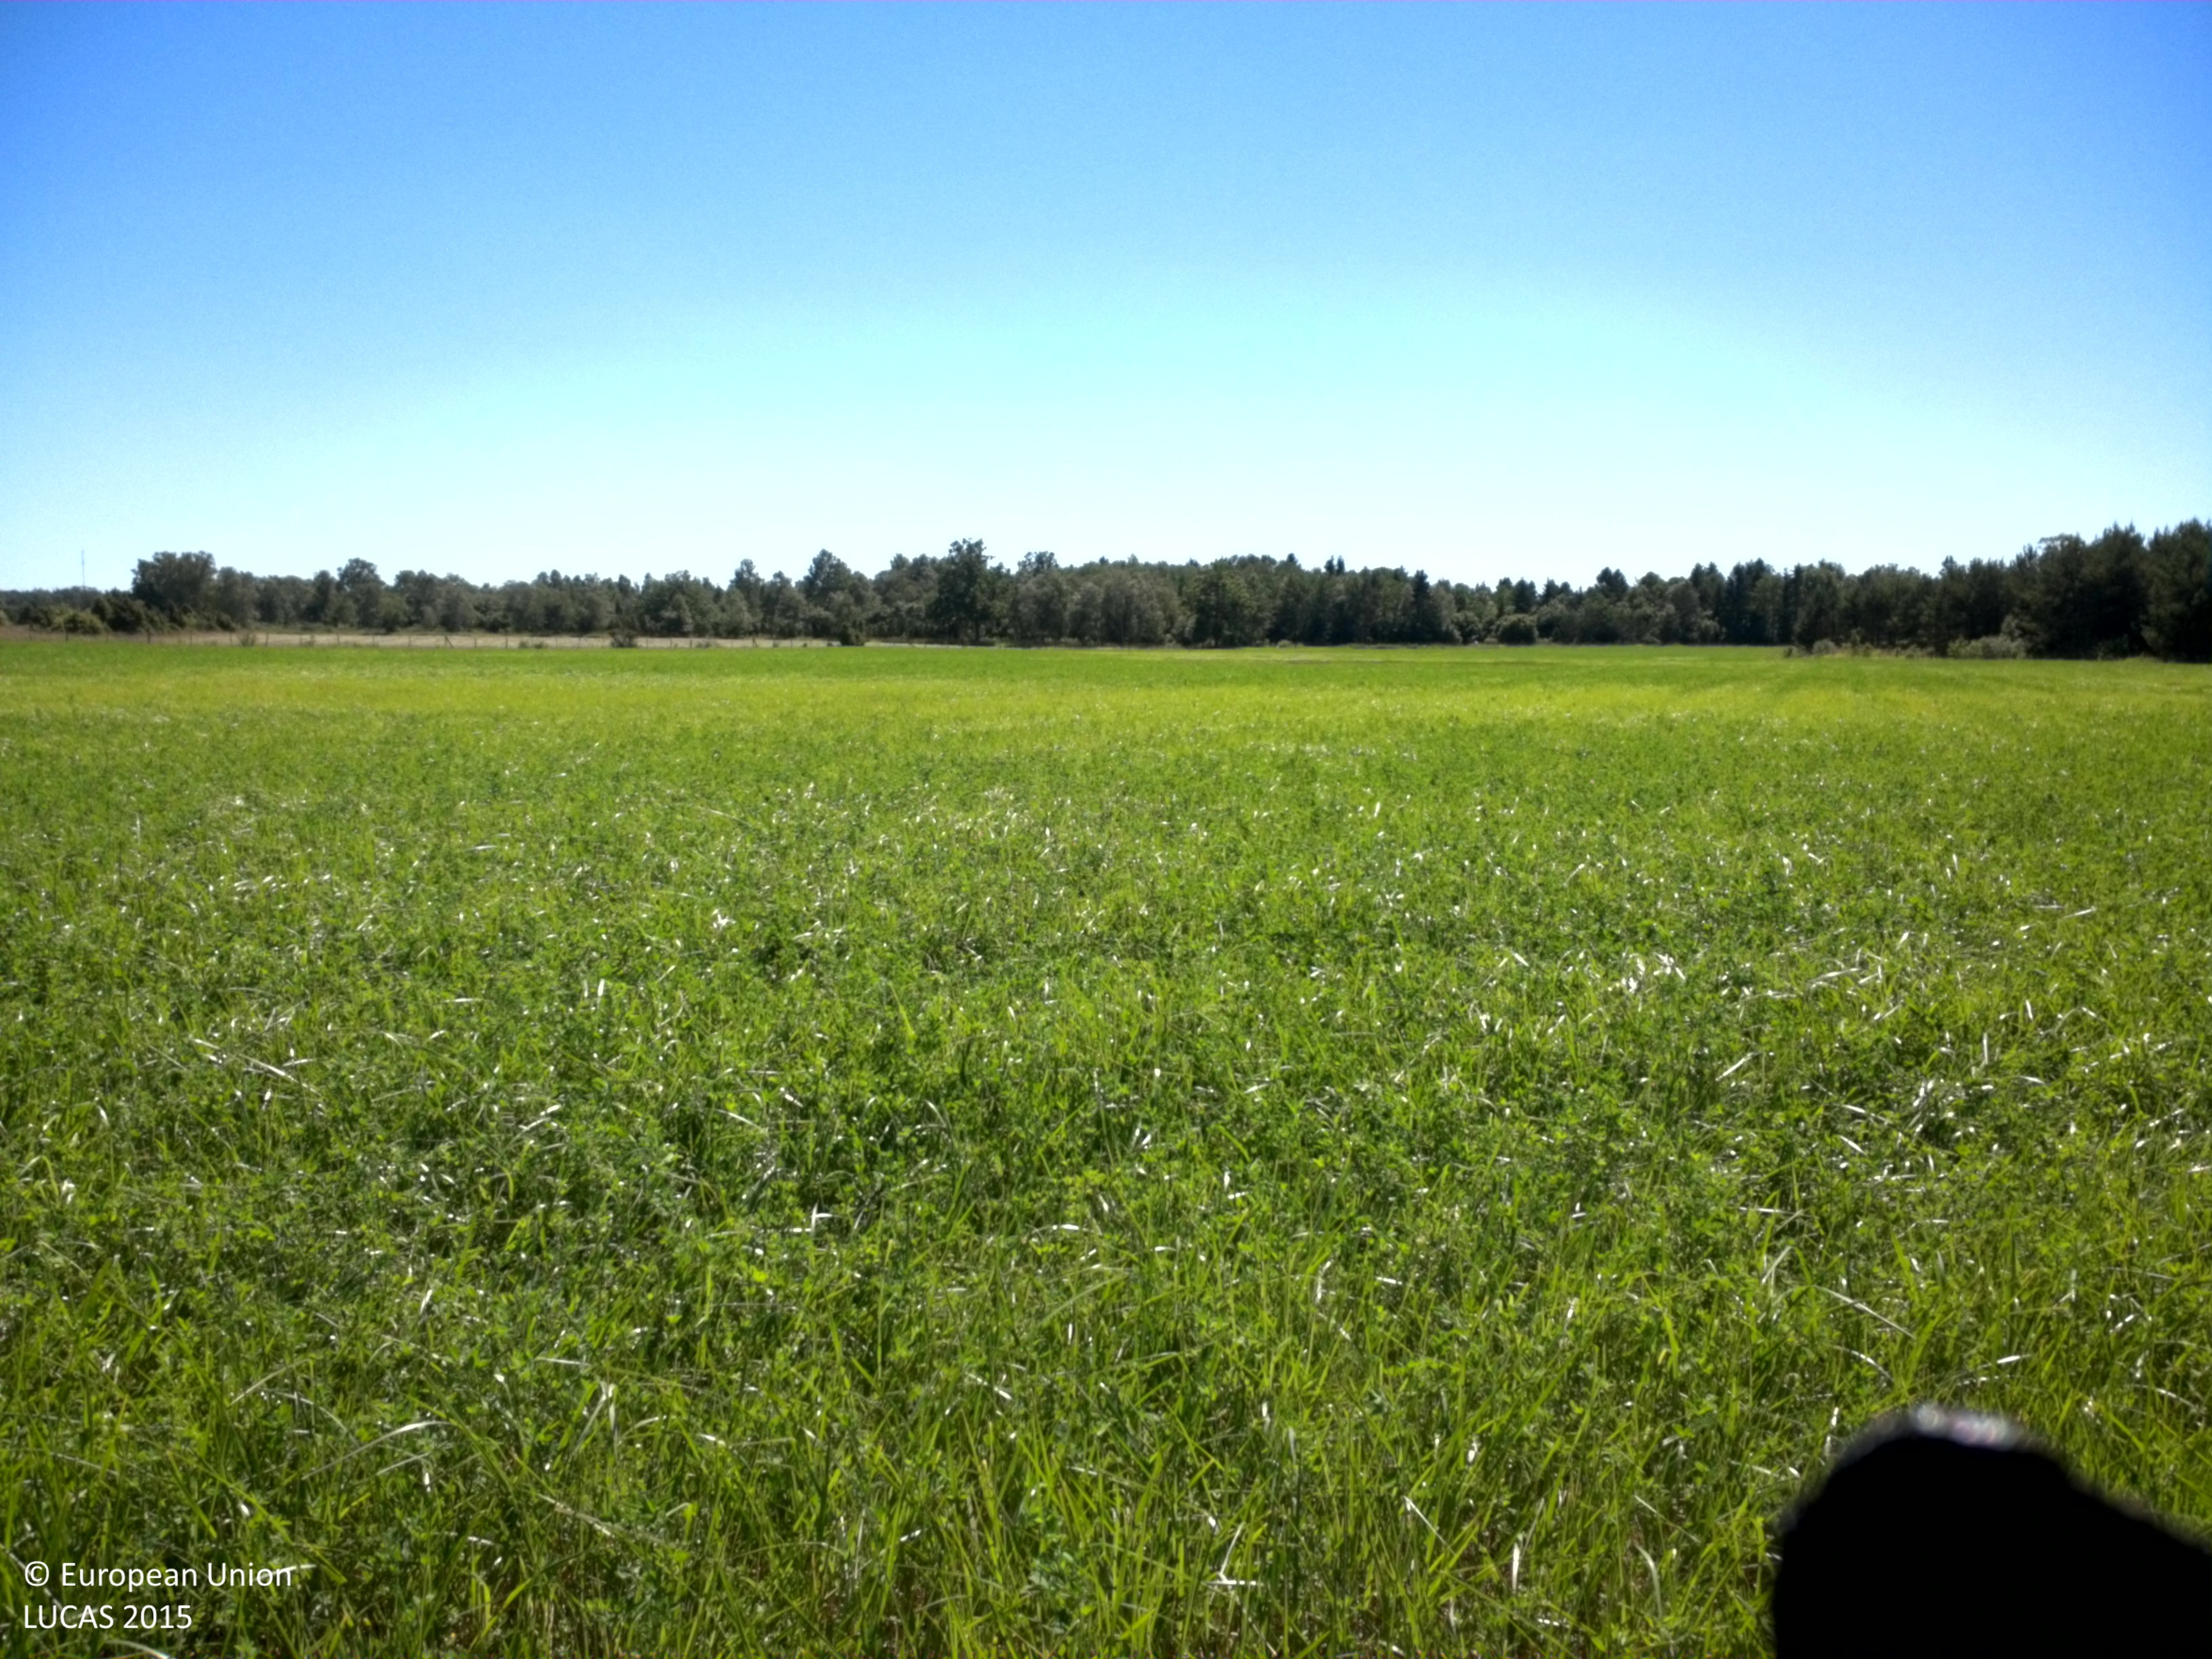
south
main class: Cropland
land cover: Lucerne
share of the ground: > 75 %
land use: Agriculture (excluding fallow land and kitchen gardens)
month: July
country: SE
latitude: 57.8075
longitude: 18.7434
